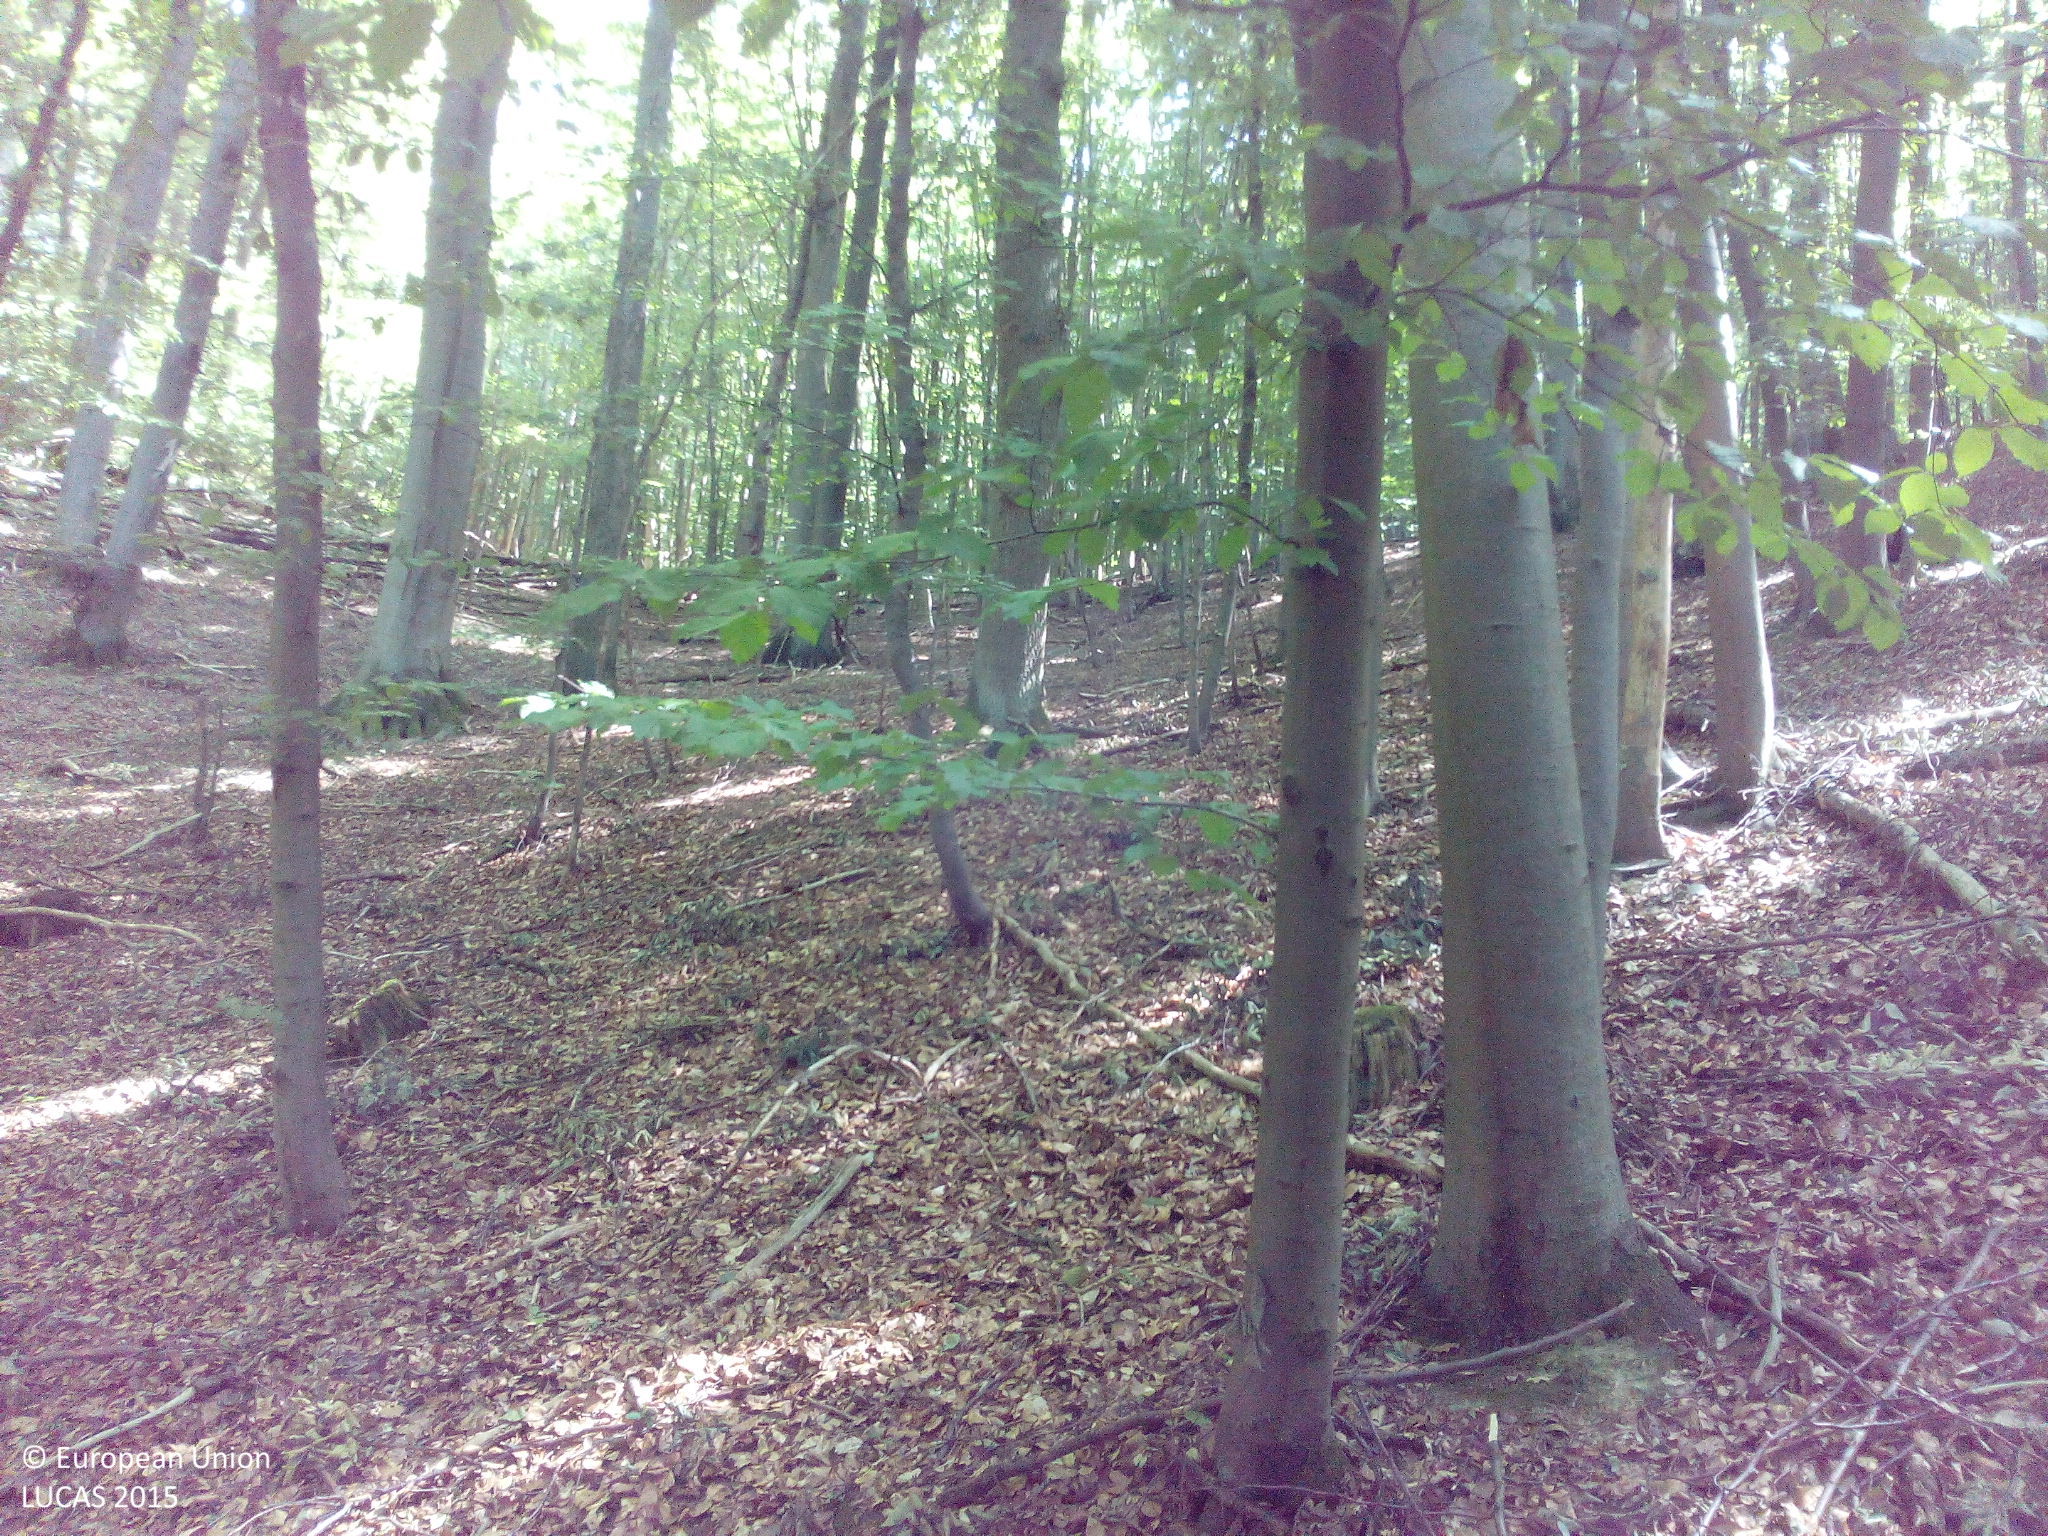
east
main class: Woodland
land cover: Broadleaved woodland
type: beech forest
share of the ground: > 75 %
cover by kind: broadleaved forest trees 100 %
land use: Forestry
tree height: > 5 m
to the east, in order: Broadleaved woodland; Tracks; Broadleaved woodland
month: August
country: DE
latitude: 51.6387
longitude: 9.3500
